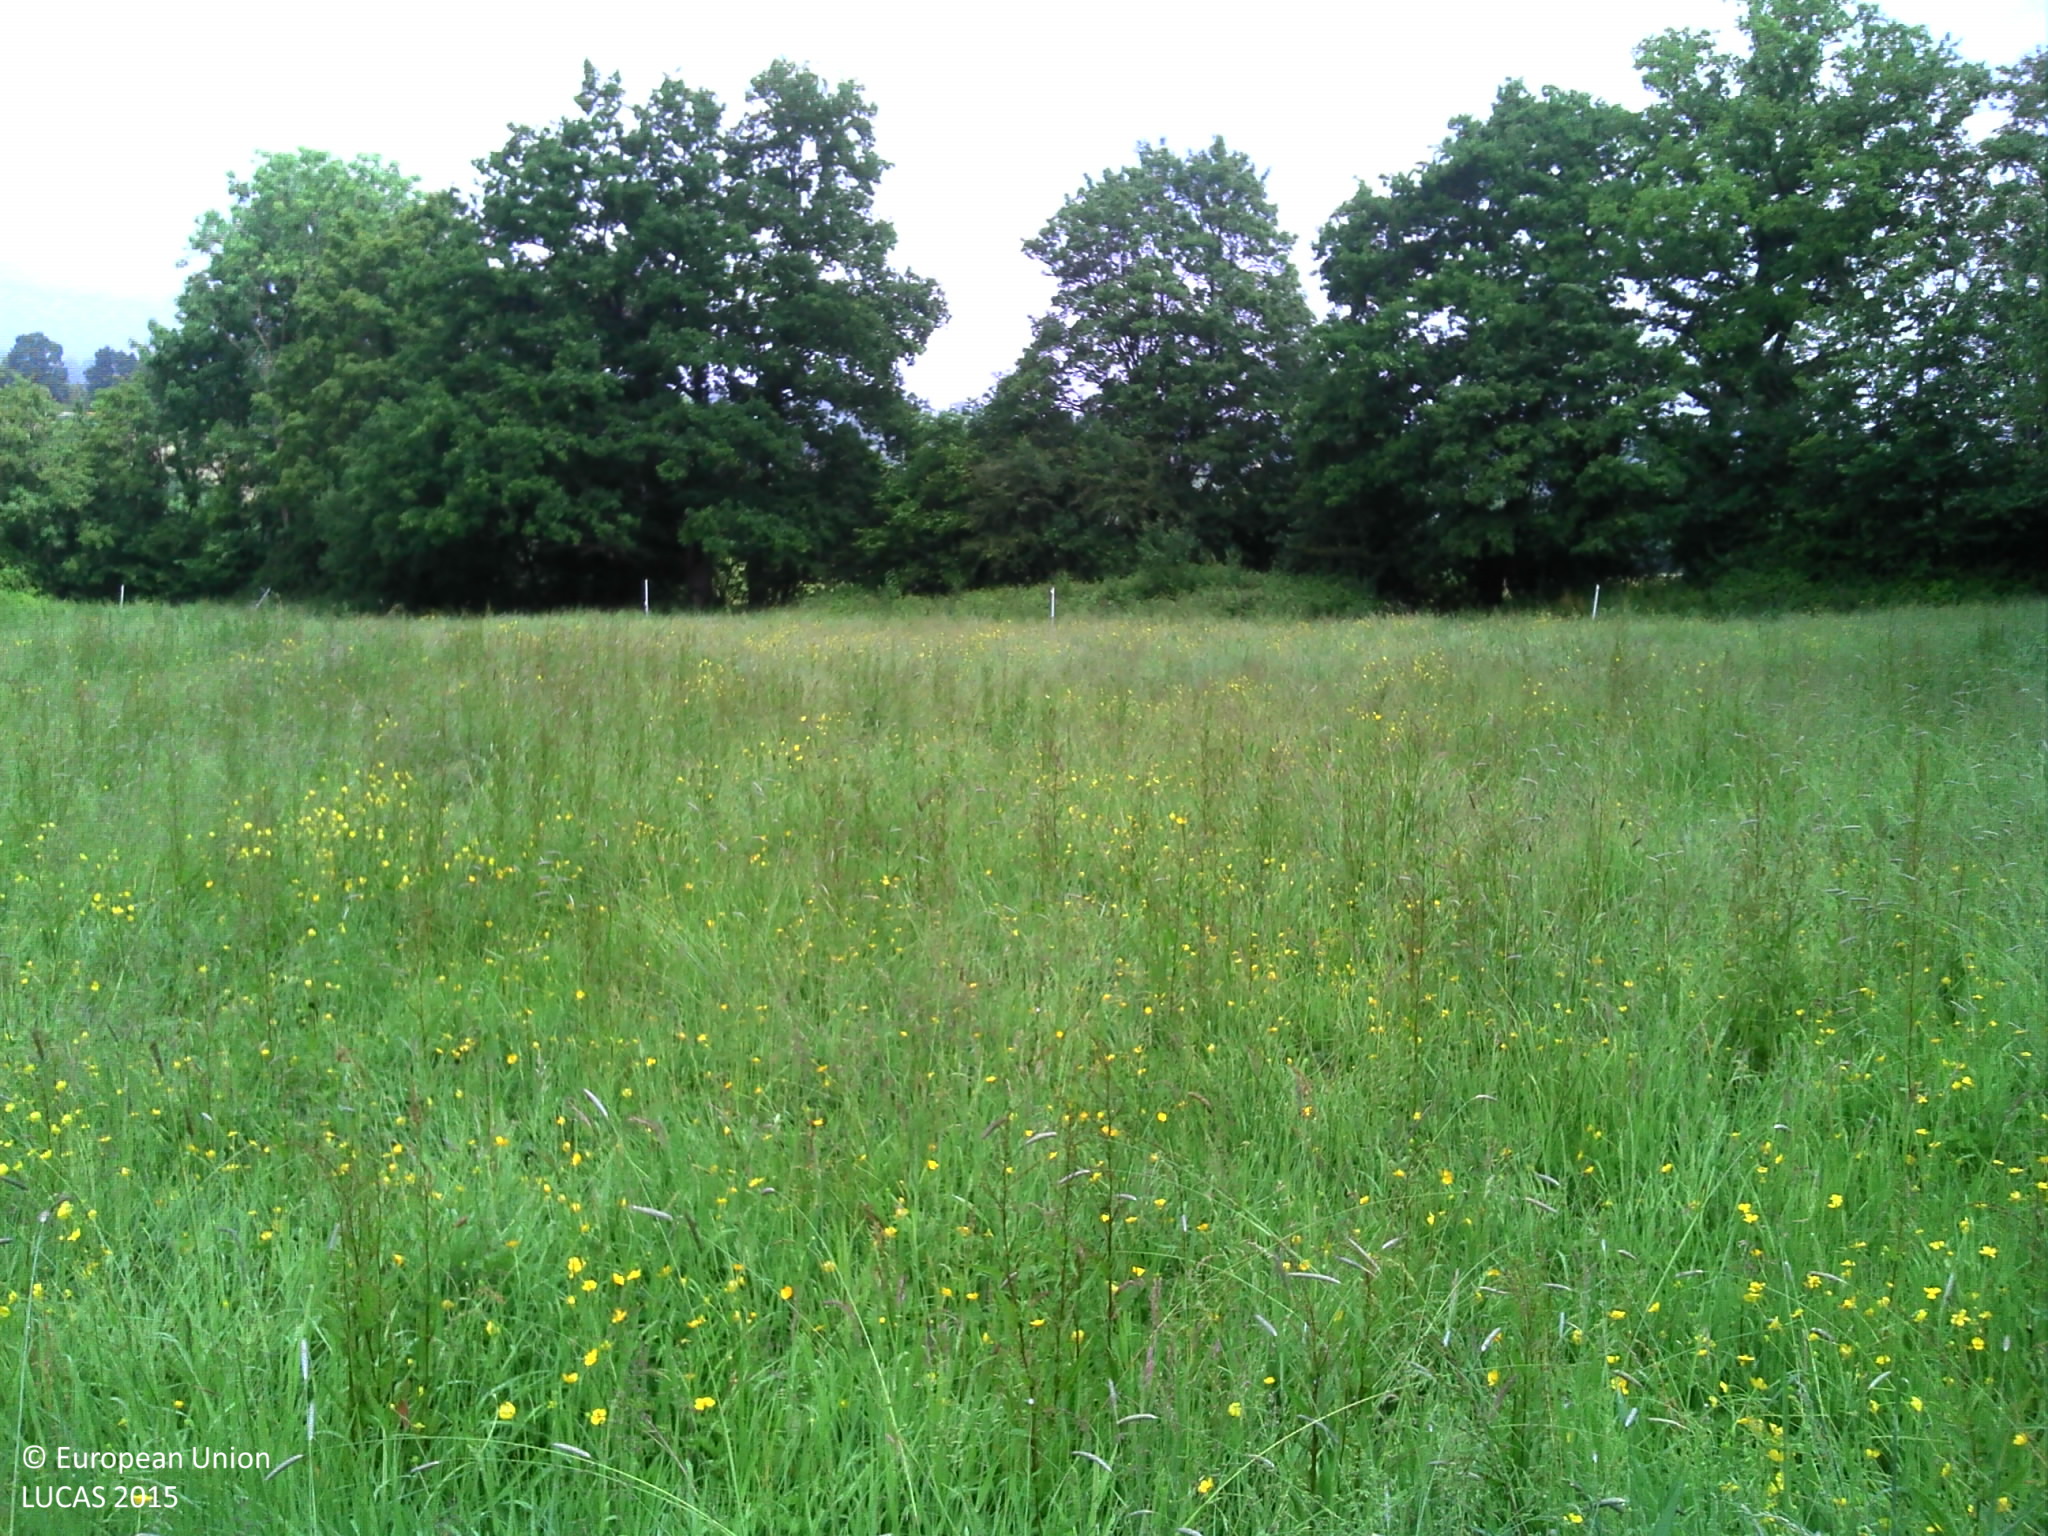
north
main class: Grassland
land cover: Grassland without tree/shrub cover
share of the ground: > 75 %
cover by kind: herbaceous plants 100 %
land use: Agriculture (excluding fallow land and kitchen gardens)
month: June
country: FR
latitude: 49.2659
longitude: 0.3388
